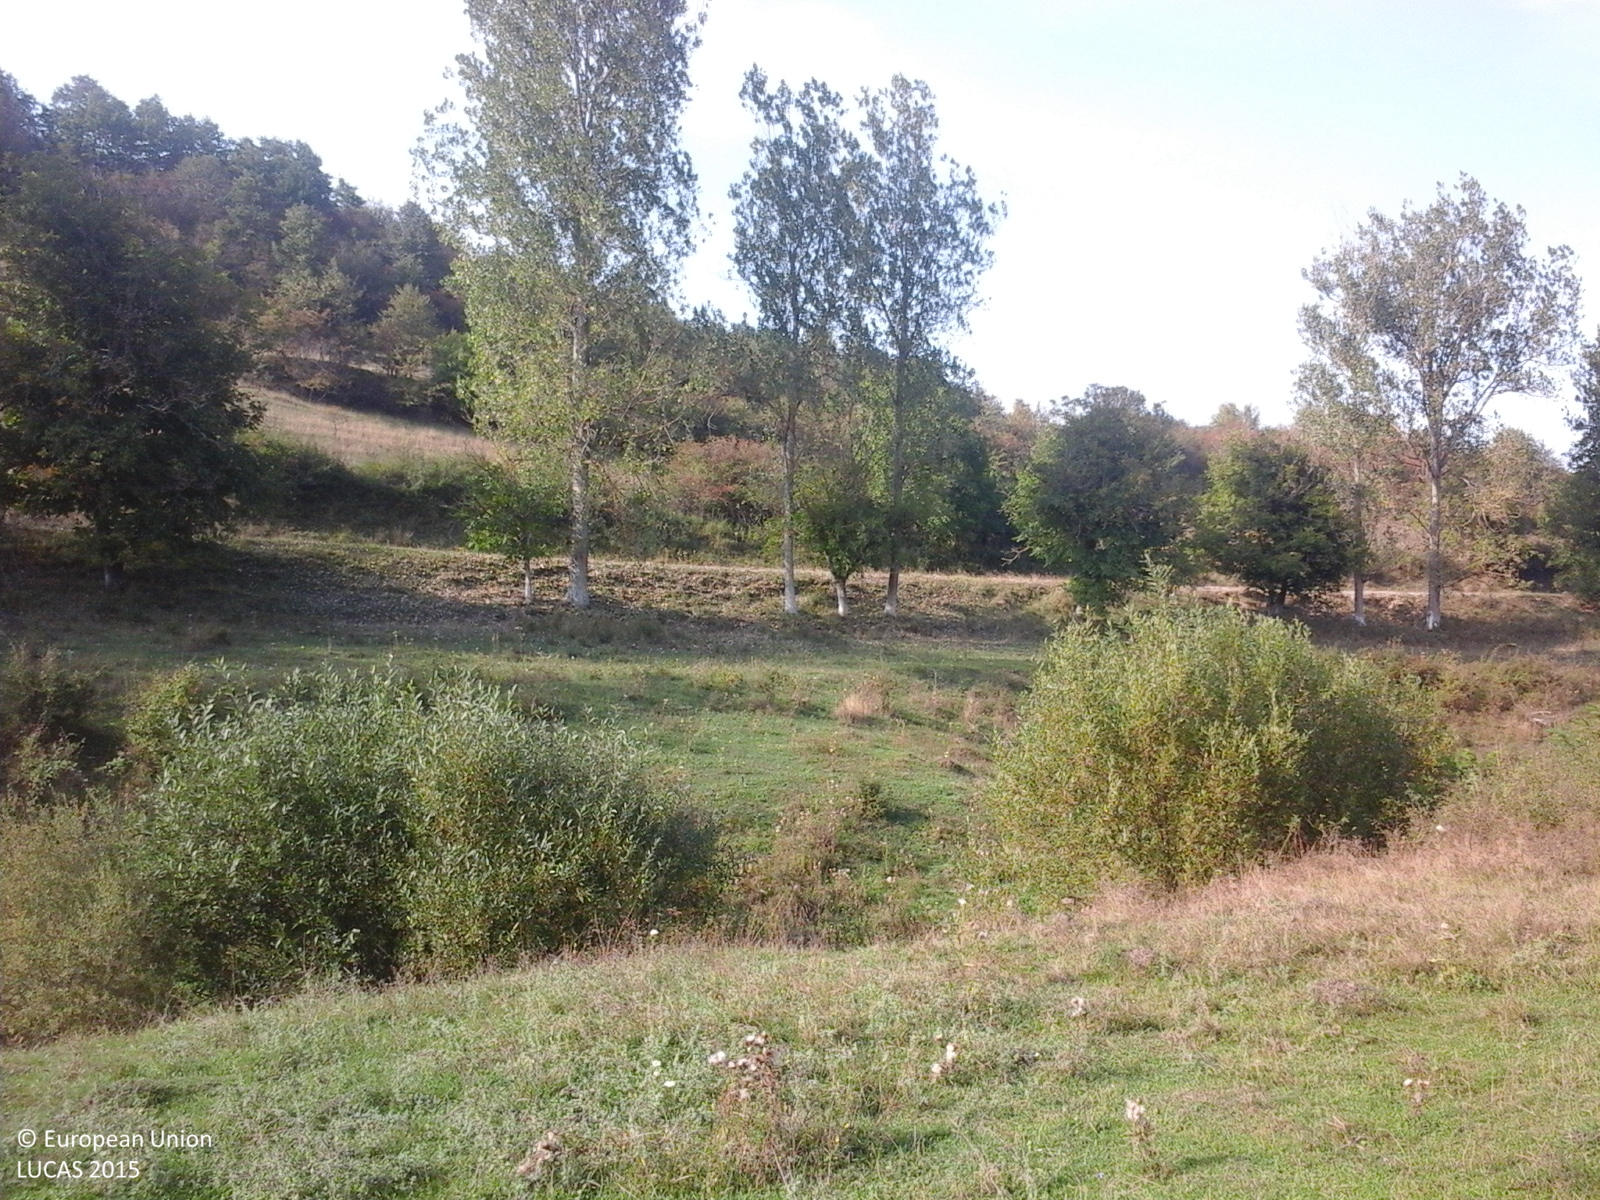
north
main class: Grassland
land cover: Grassland without tree/shrub cover
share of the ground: > 75 %
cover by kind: herbaceous plants 100 %
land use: Agriculture (excluding fallow land and kitchen gardens)
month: September
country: RO
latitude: 47.0184
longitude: 23.3957
